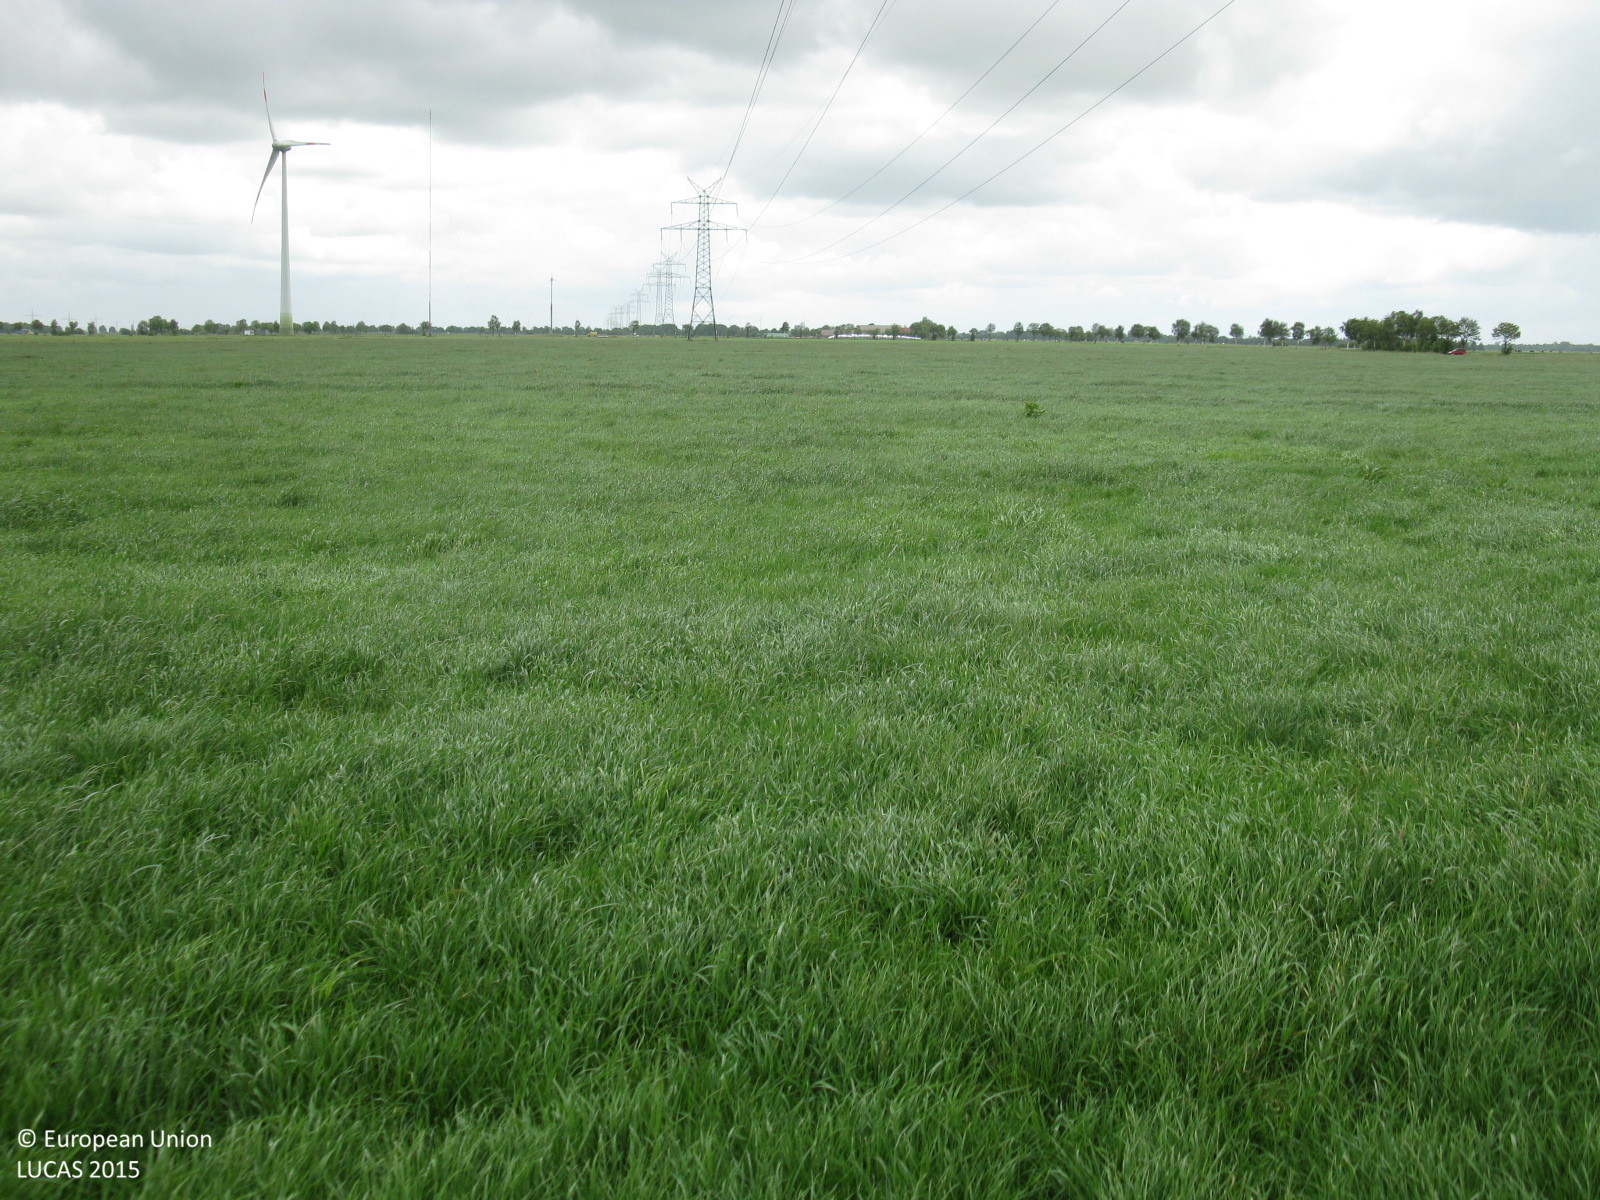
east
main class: Grassland
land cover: Grassland without tree/shrub cover
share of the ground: > 75 %
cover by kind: herbaceous plants 100 %
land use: Agriculture (excluding fallow land and kitchen gardens)
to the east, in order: Grassland without tree/shrub cover; Electric lines
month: June
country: DE
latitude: 53.3554
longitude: 7.3713
